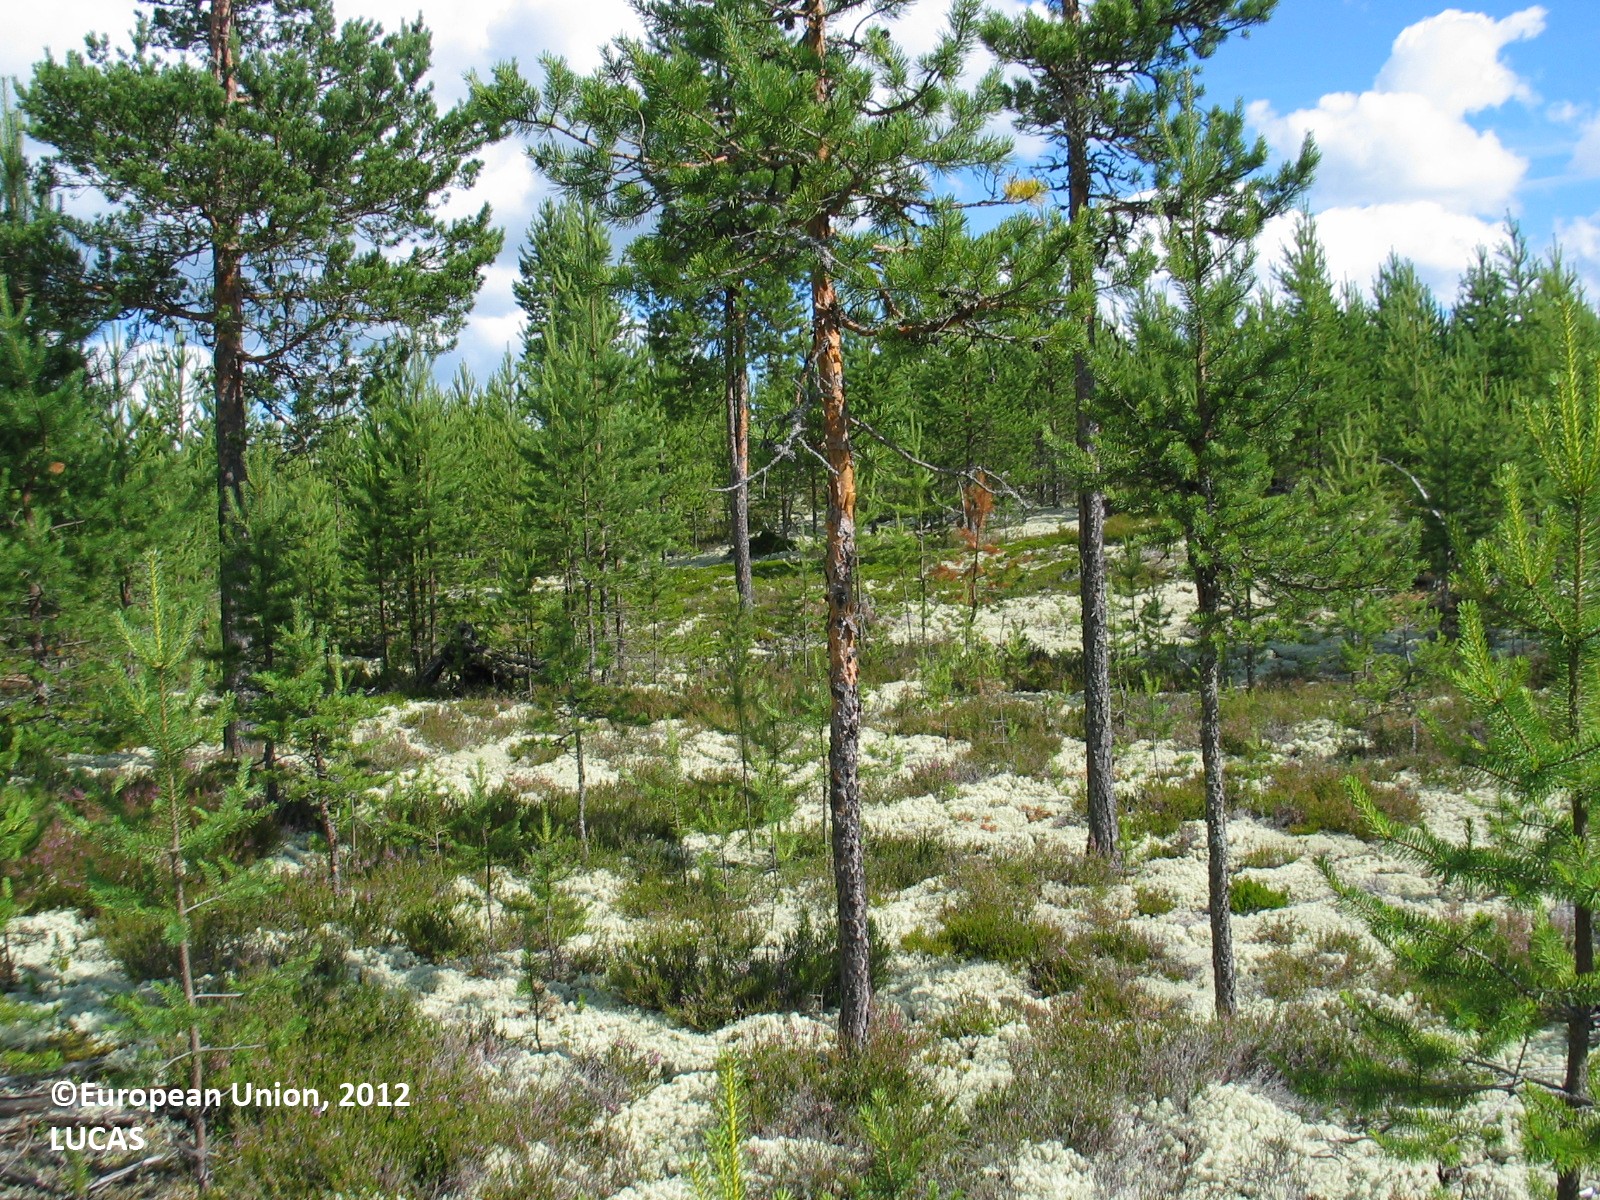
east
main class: Woodland
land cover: Pine dominated coniferous woodland
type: boreal forest
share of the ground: 25 - 50 %
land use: Forestry
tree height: > 5 m
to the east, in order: Pine dominated coniferous woodland; Tracks; Pine dominated coniferous woodland
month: July
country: FI
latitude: 64.6077
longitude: 26.4350
